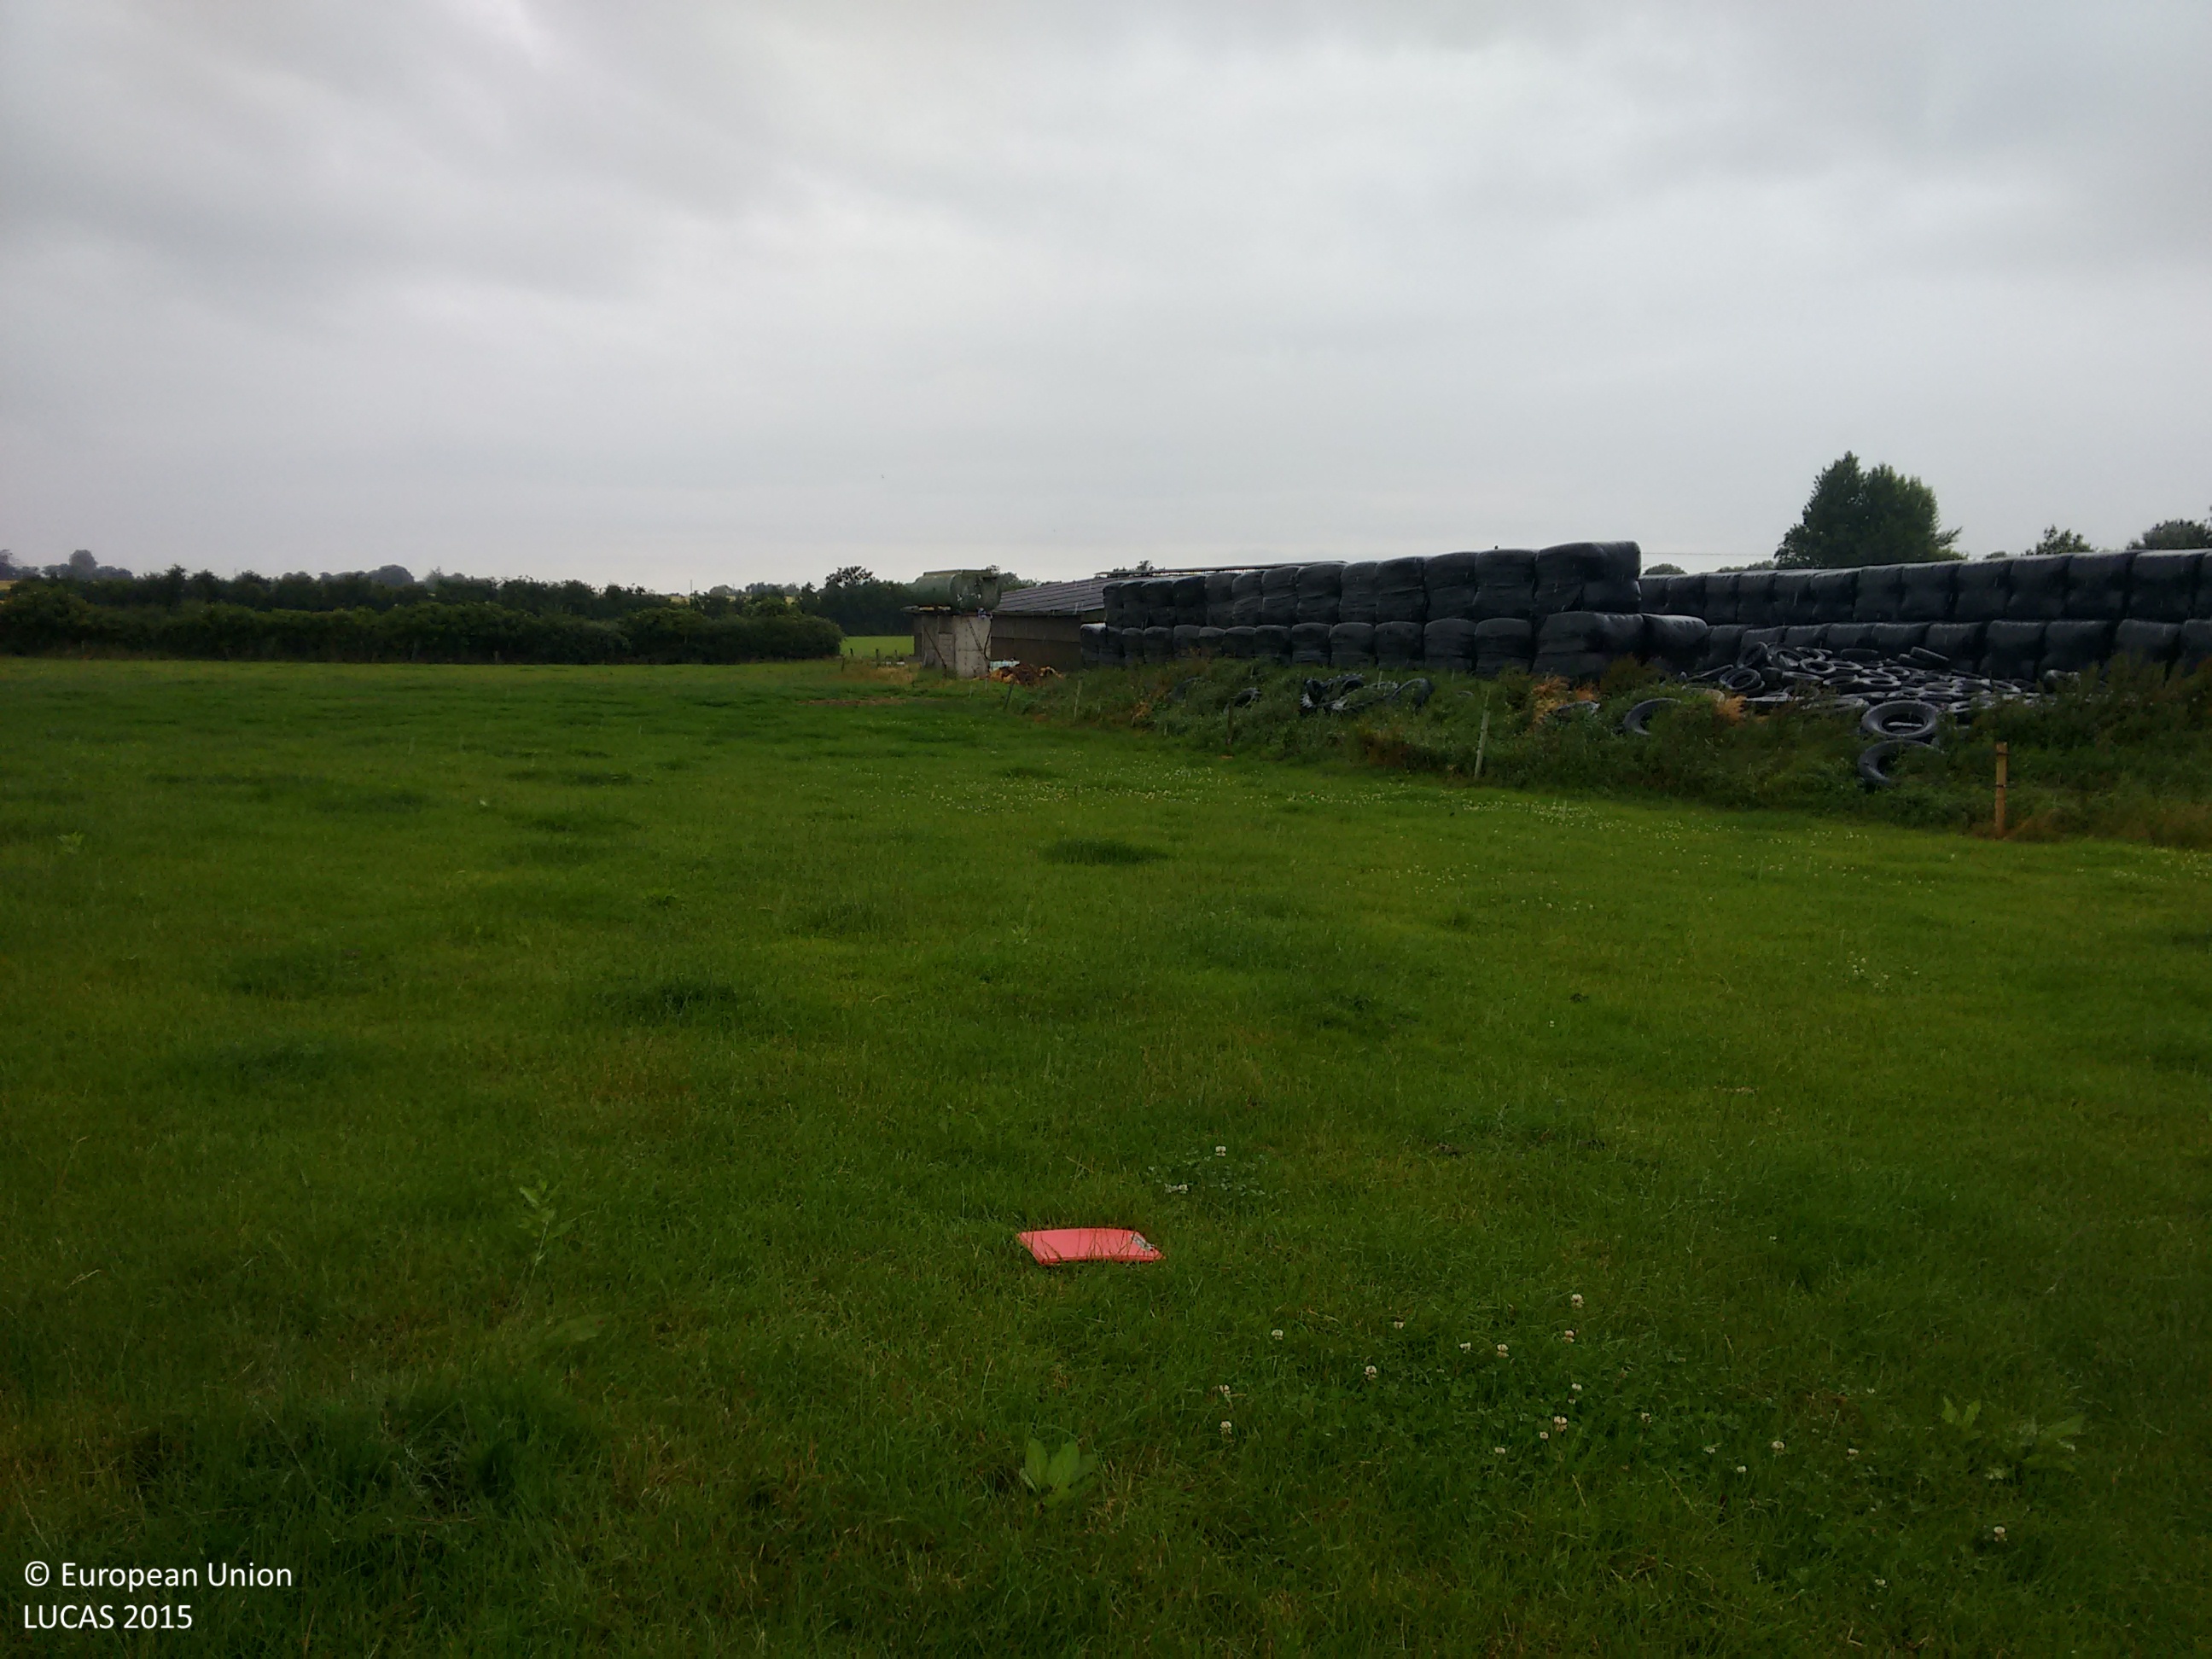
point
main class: Grassland
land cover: Grassland without tree/shrub cover
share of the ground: > 75 %
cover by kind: herbaceous plants 100 %
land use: Agriculture (excluding fallow land and kitchen gardens)
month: July
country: IE
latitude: 52.5947
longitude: -7.2304
